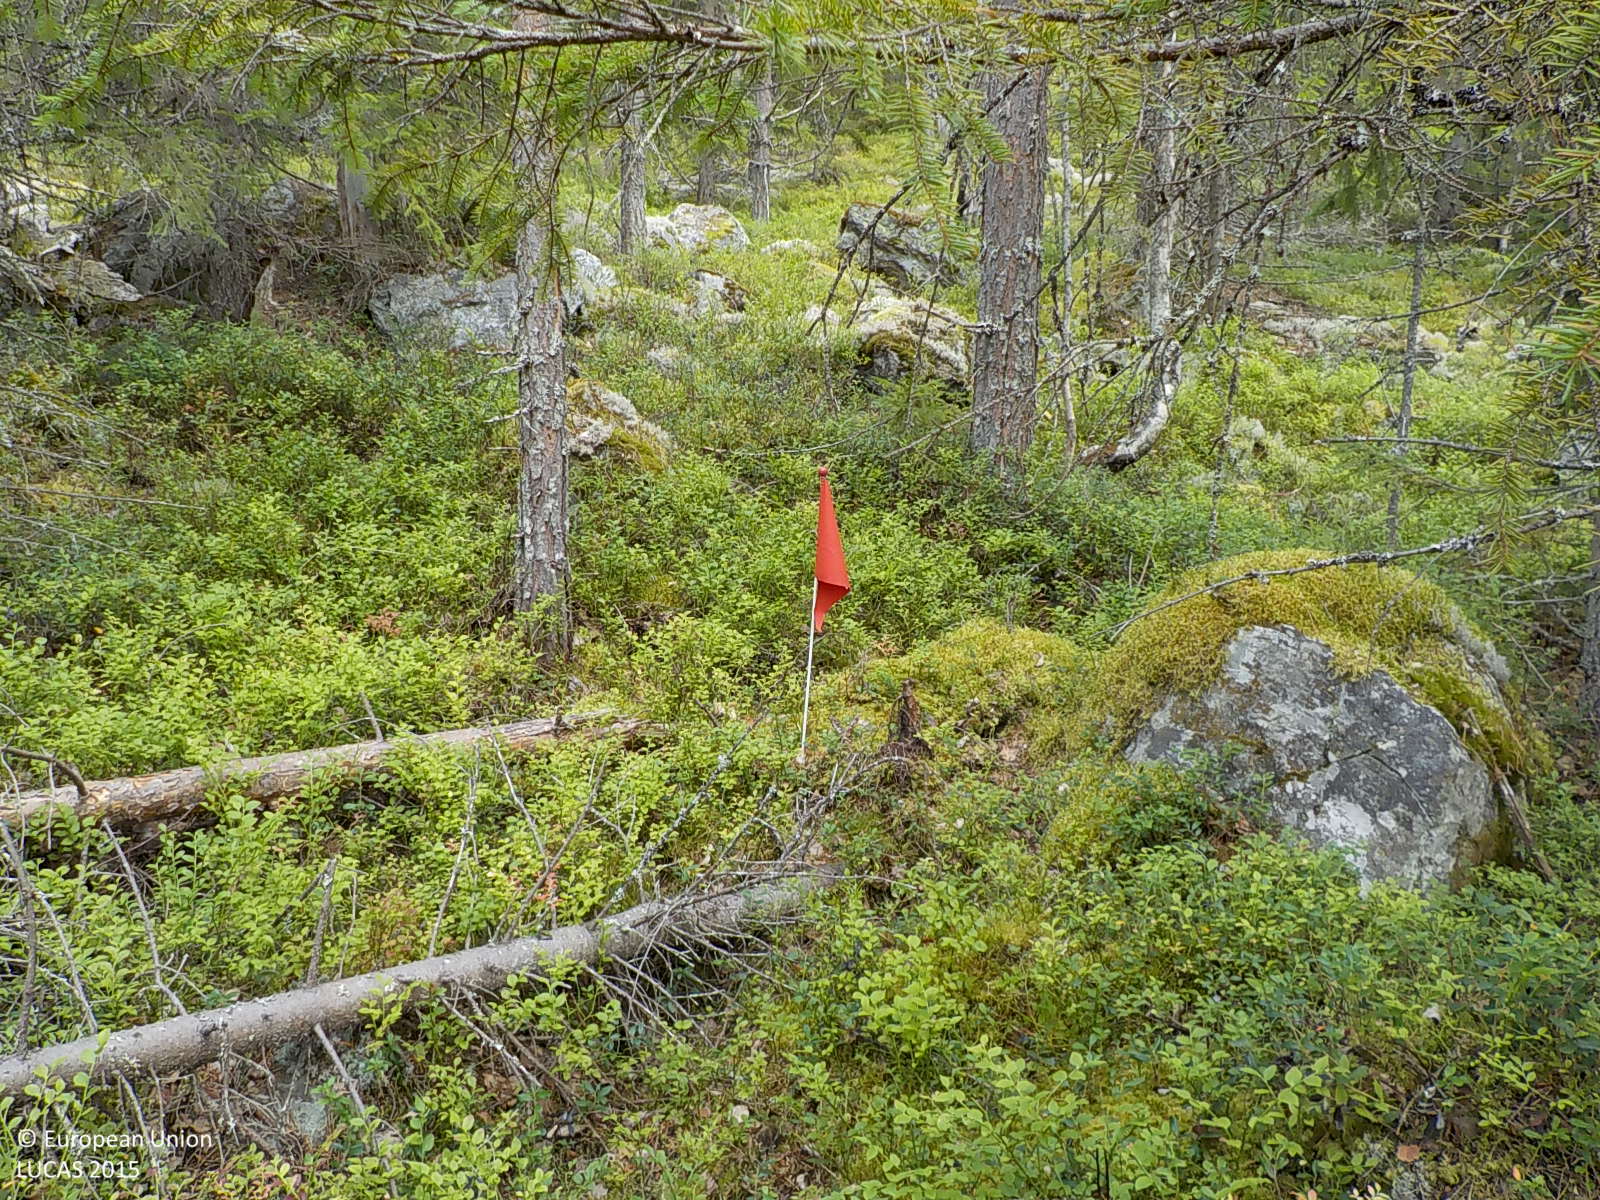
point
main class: Woodland
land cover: Pine dominated coniferous woodland
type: boreal forest
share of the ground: > 75 %
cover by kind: coniferous forest trees 80 %, shrubs 10 %, broadleaved forest trees 5 %, lichens and mosses 5 %
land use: Forestry
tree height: > 5 m
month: September
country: SE
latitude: 63.2443
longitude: 17.8008
